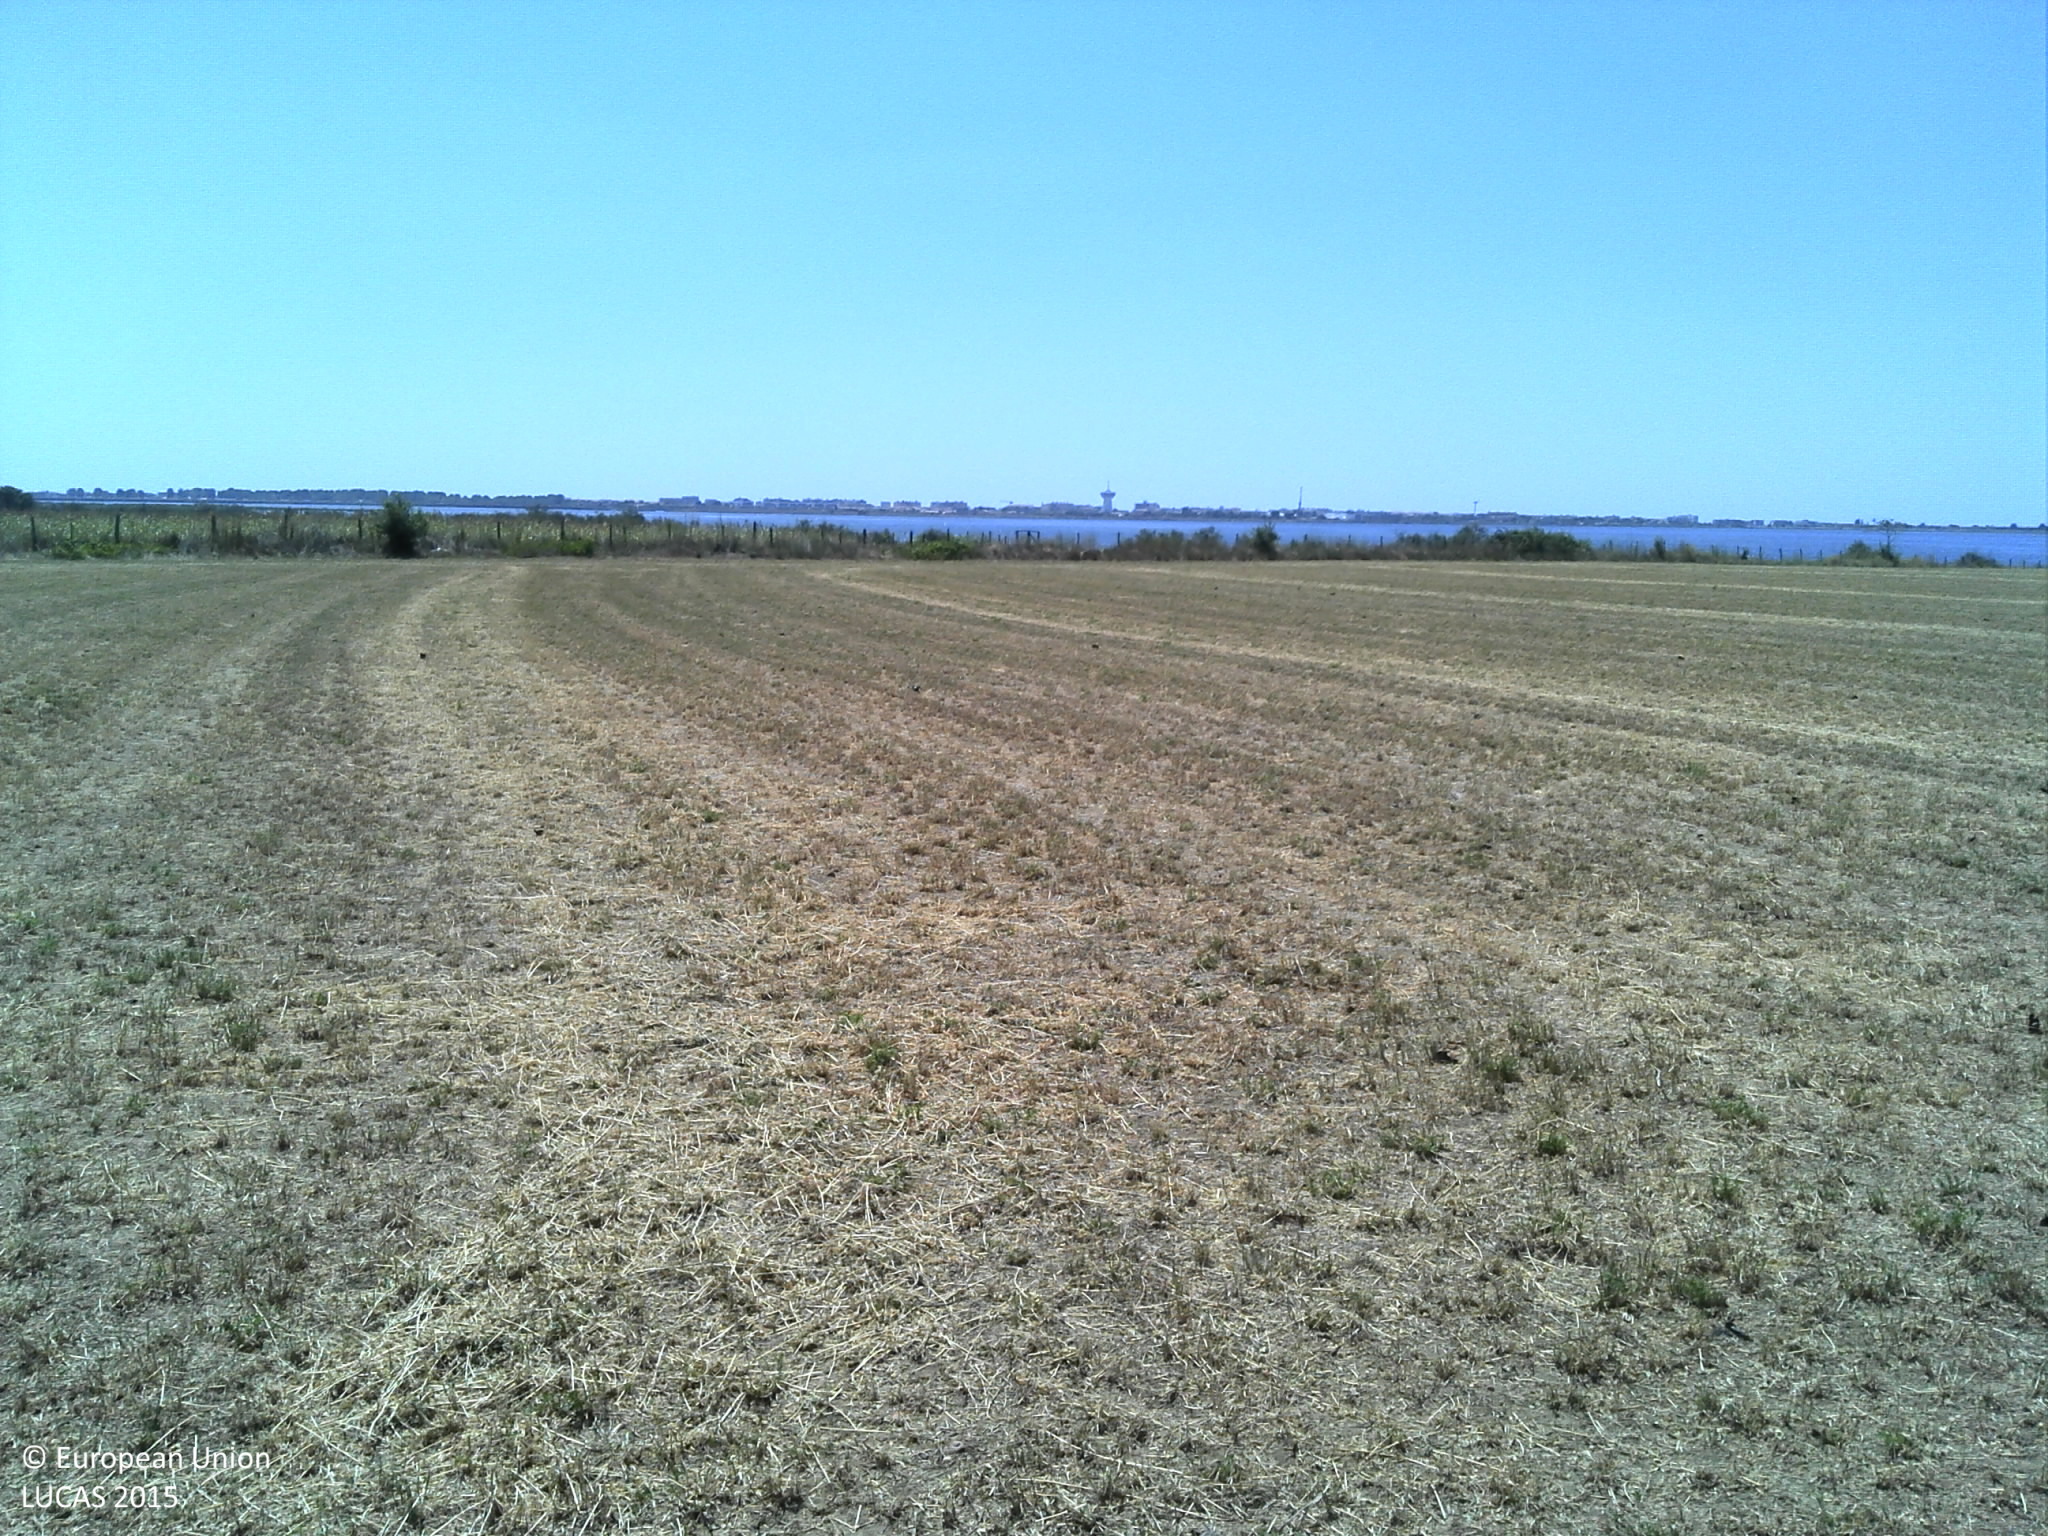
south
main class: Cropland
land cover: Temporary grasslands
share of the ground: > 75 %
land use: Agriculture (excluding fallow land and kitchen gardens)
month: July
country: FR
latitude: 43.5579
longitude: 3.9312
